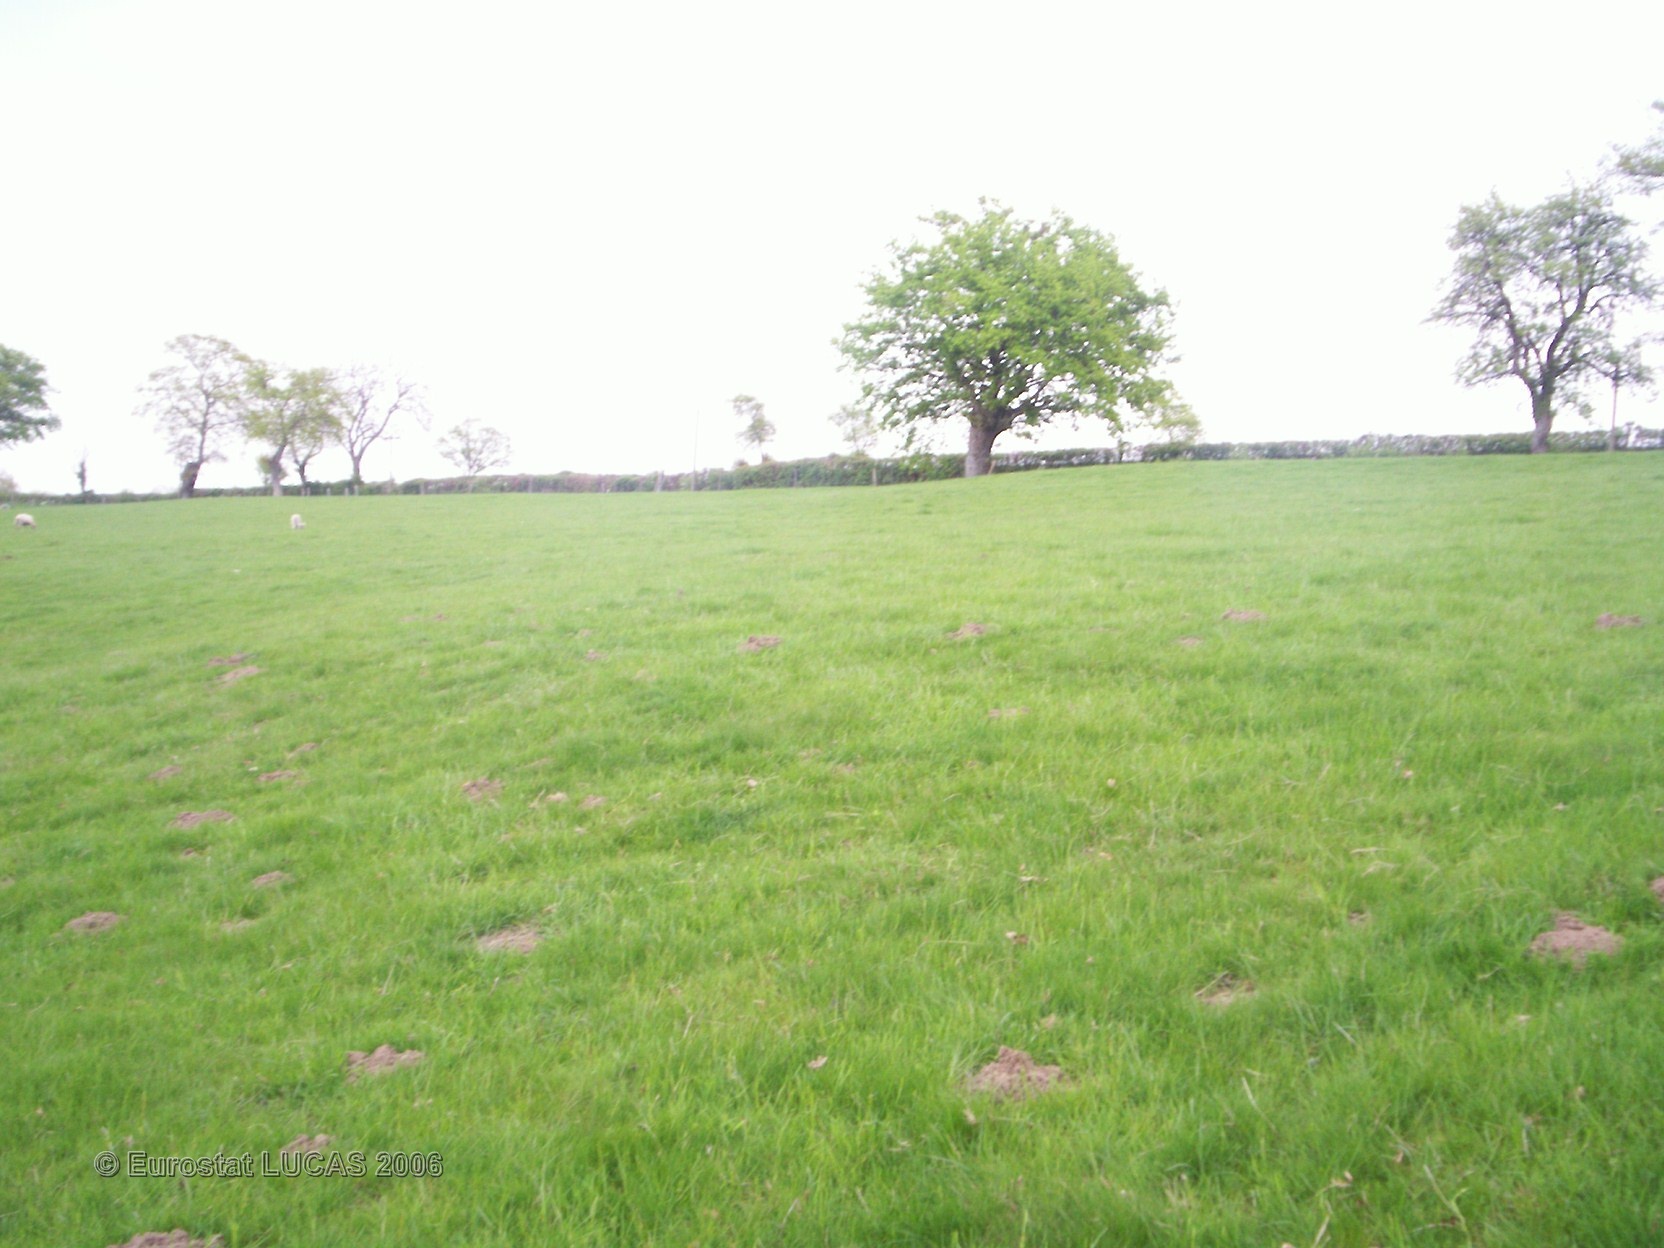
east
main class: Grassland
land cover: Grassland without tree/shrub cover
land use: Agriculture (excluding fallow land and kitchen gardens)
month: May
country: FR
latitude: 46.4722
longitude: 3.1081
